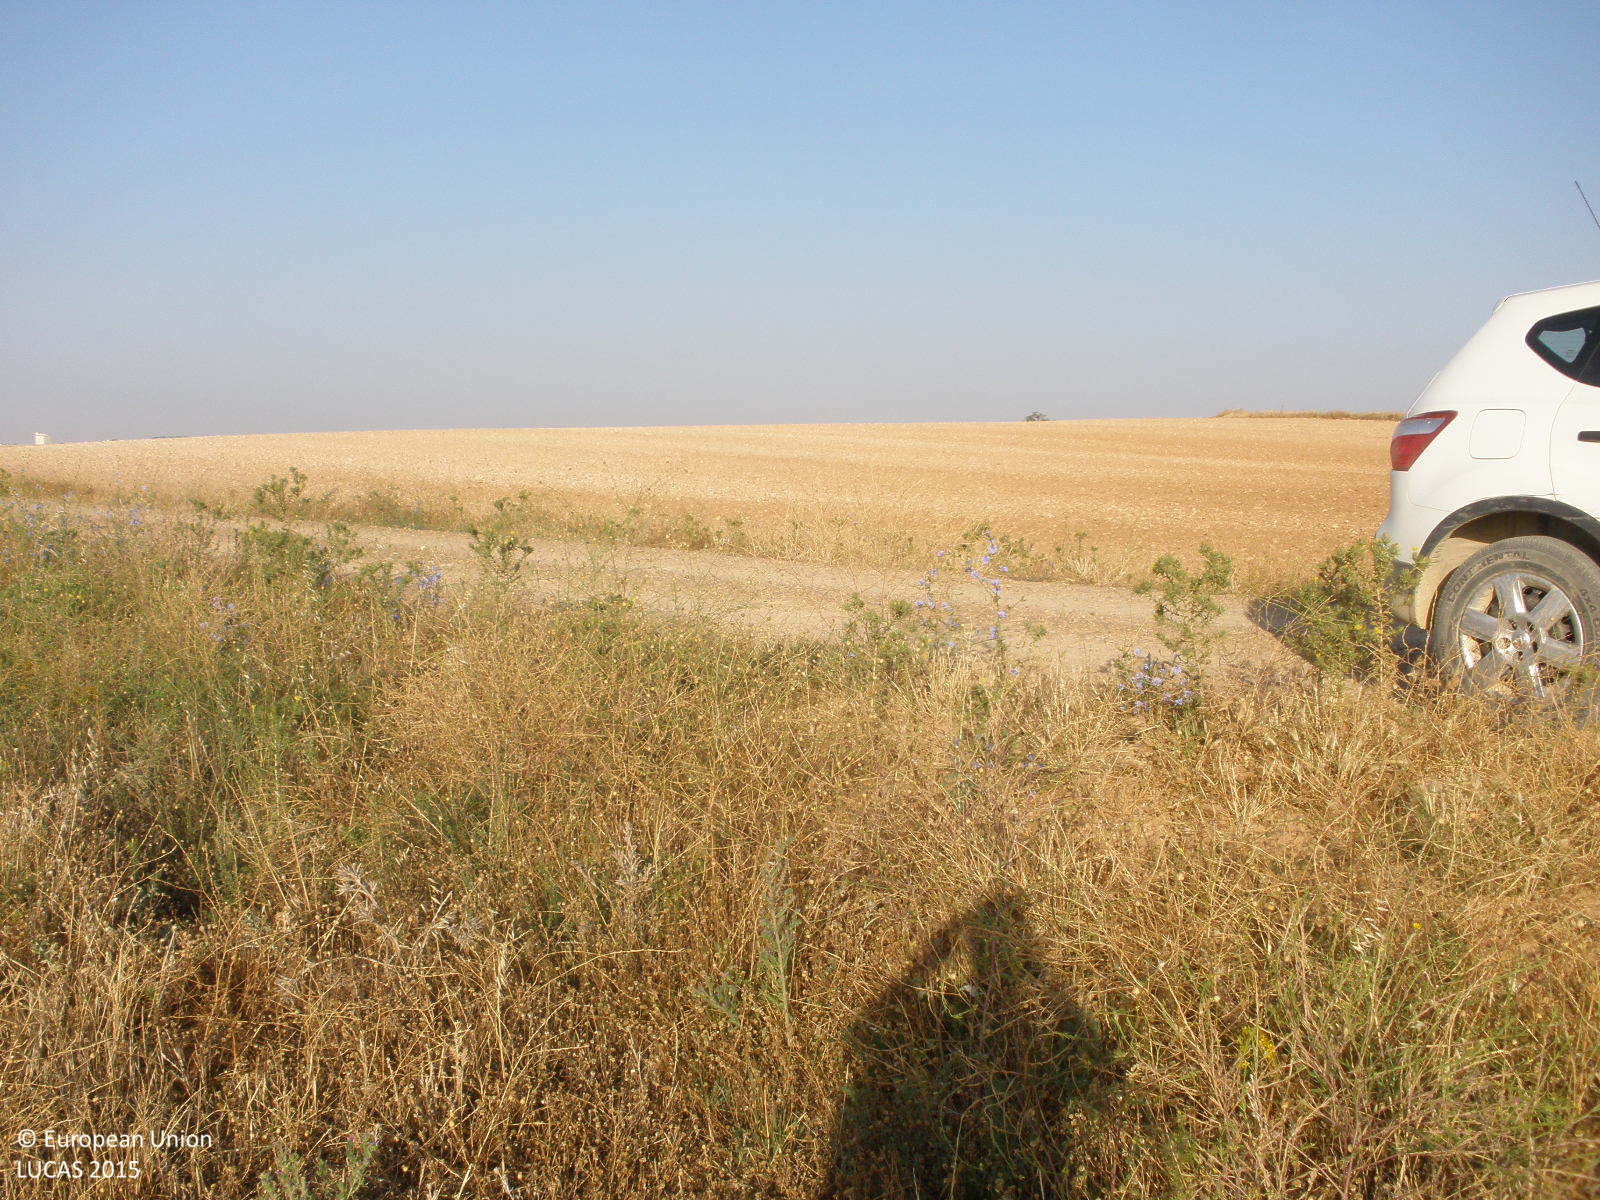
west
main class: Grassland
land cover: Spontaneously vegetated surfaces
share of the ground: > 75 %
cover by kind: herbaceous plants 85 %, unconsolidated bare surface 15 %
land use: Fallow land
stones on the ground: 25 - 50 %
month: July
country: ES
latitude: 39.9242
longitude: -3.3060
